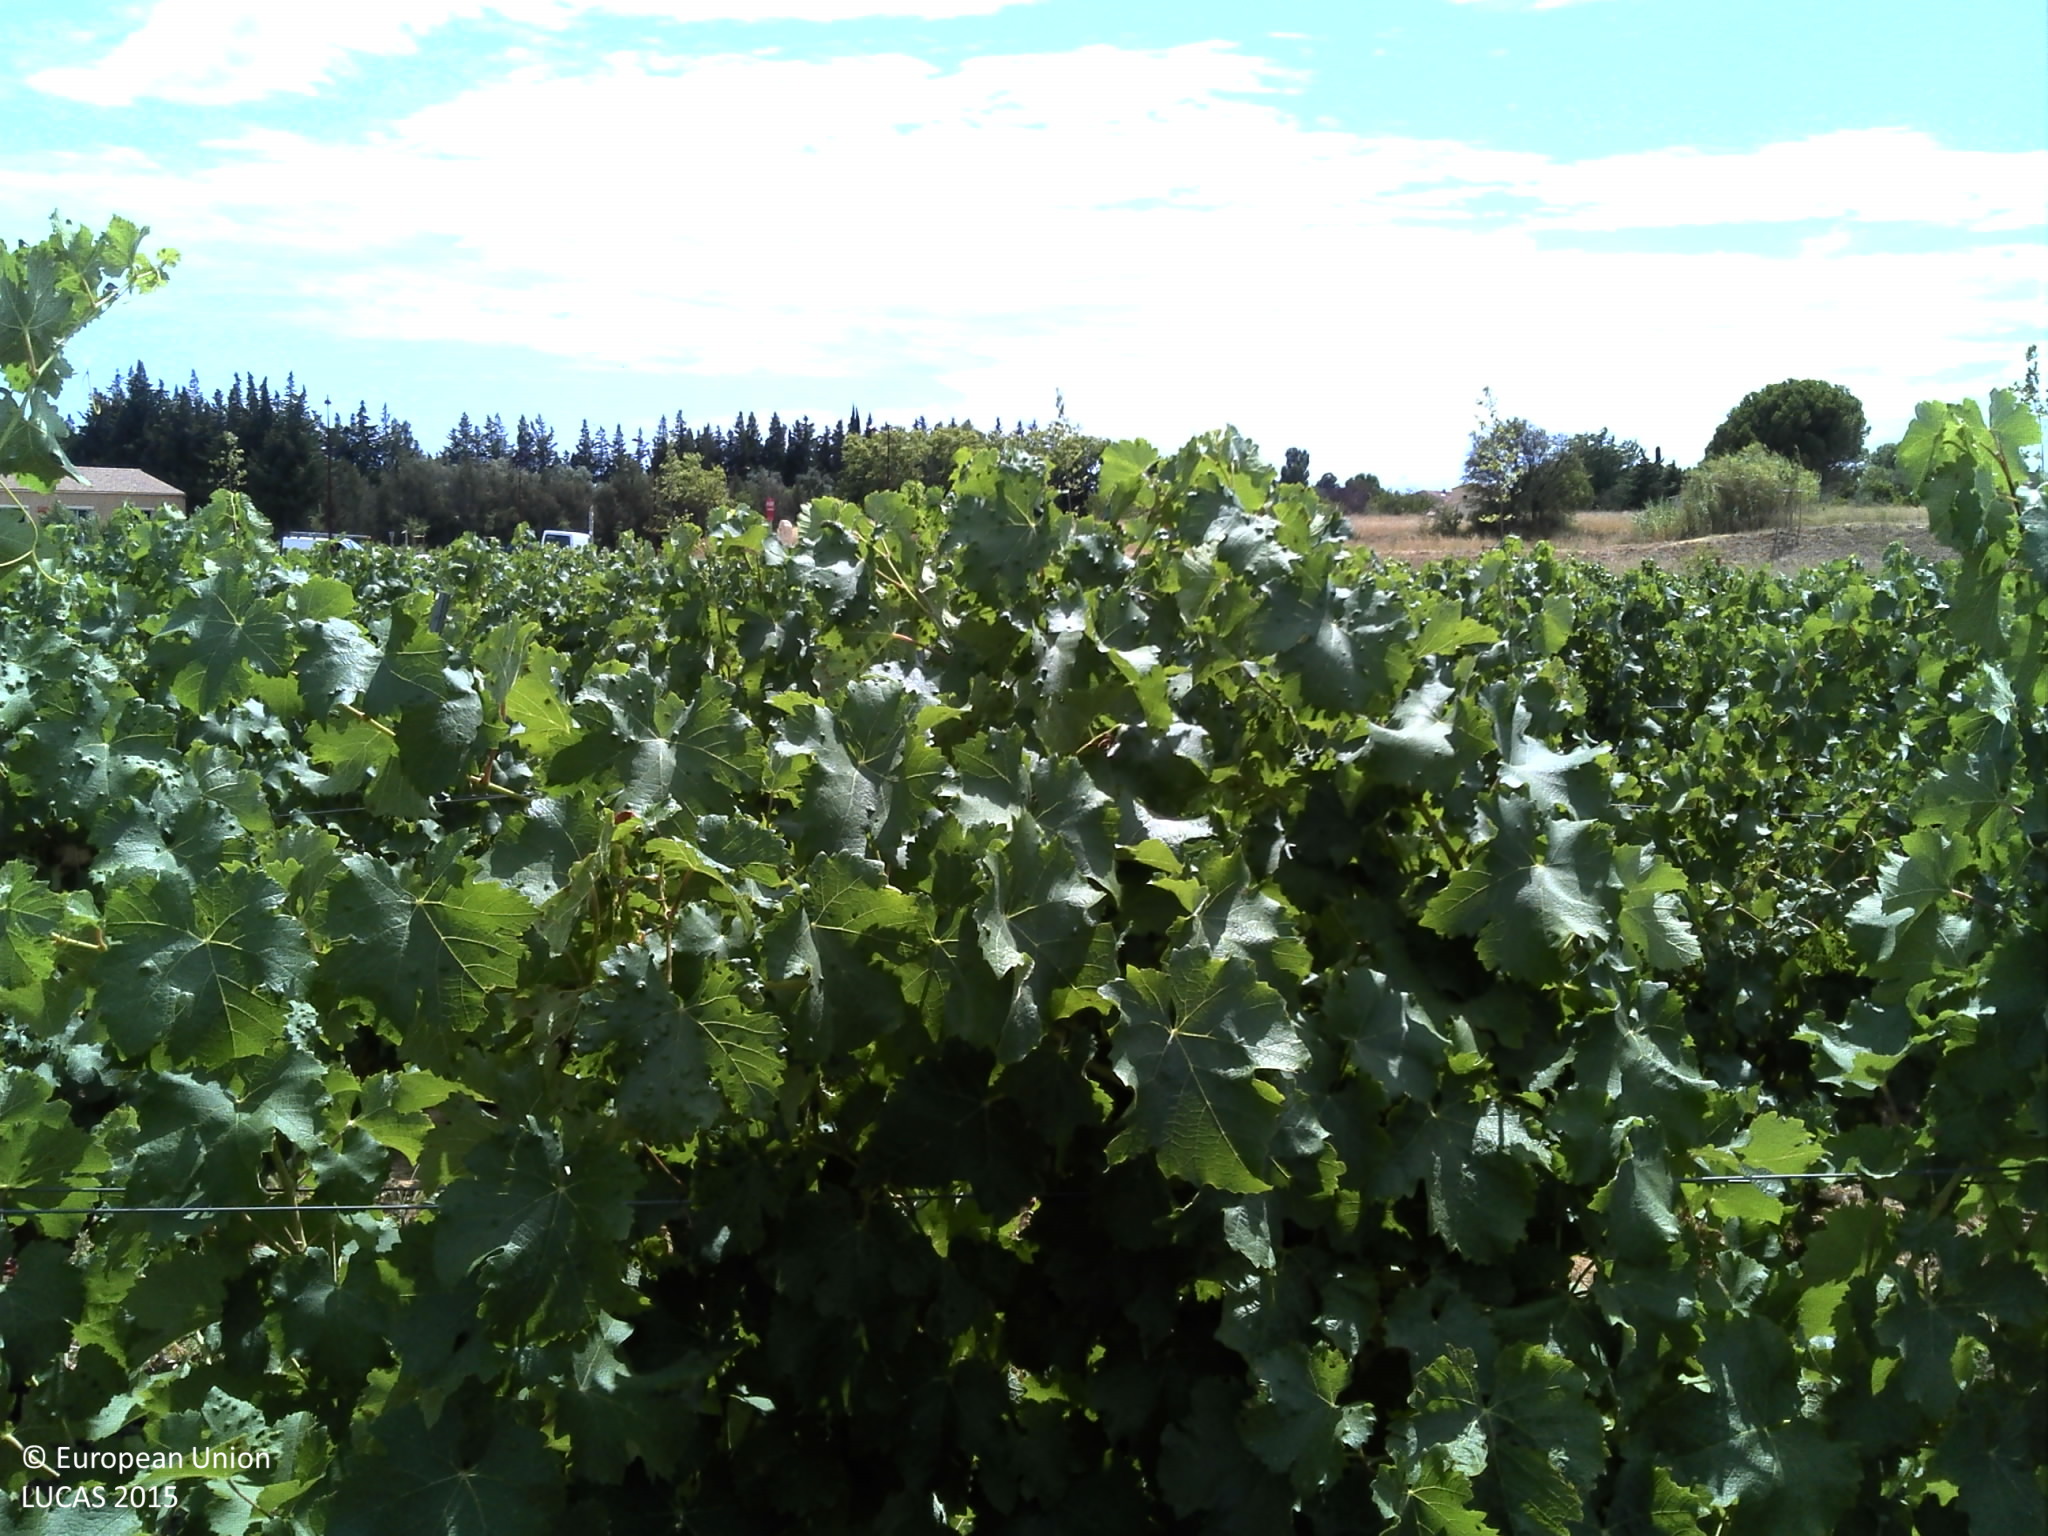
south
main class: Cropland
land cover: Vineyards
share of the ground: 25 - 50 %
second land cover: Other bare soil
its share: > 75 %
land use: Agriculture (excluding fallow land and kitchen gardens)
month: July
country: FR
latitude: 43.5025
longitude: 3.6151
